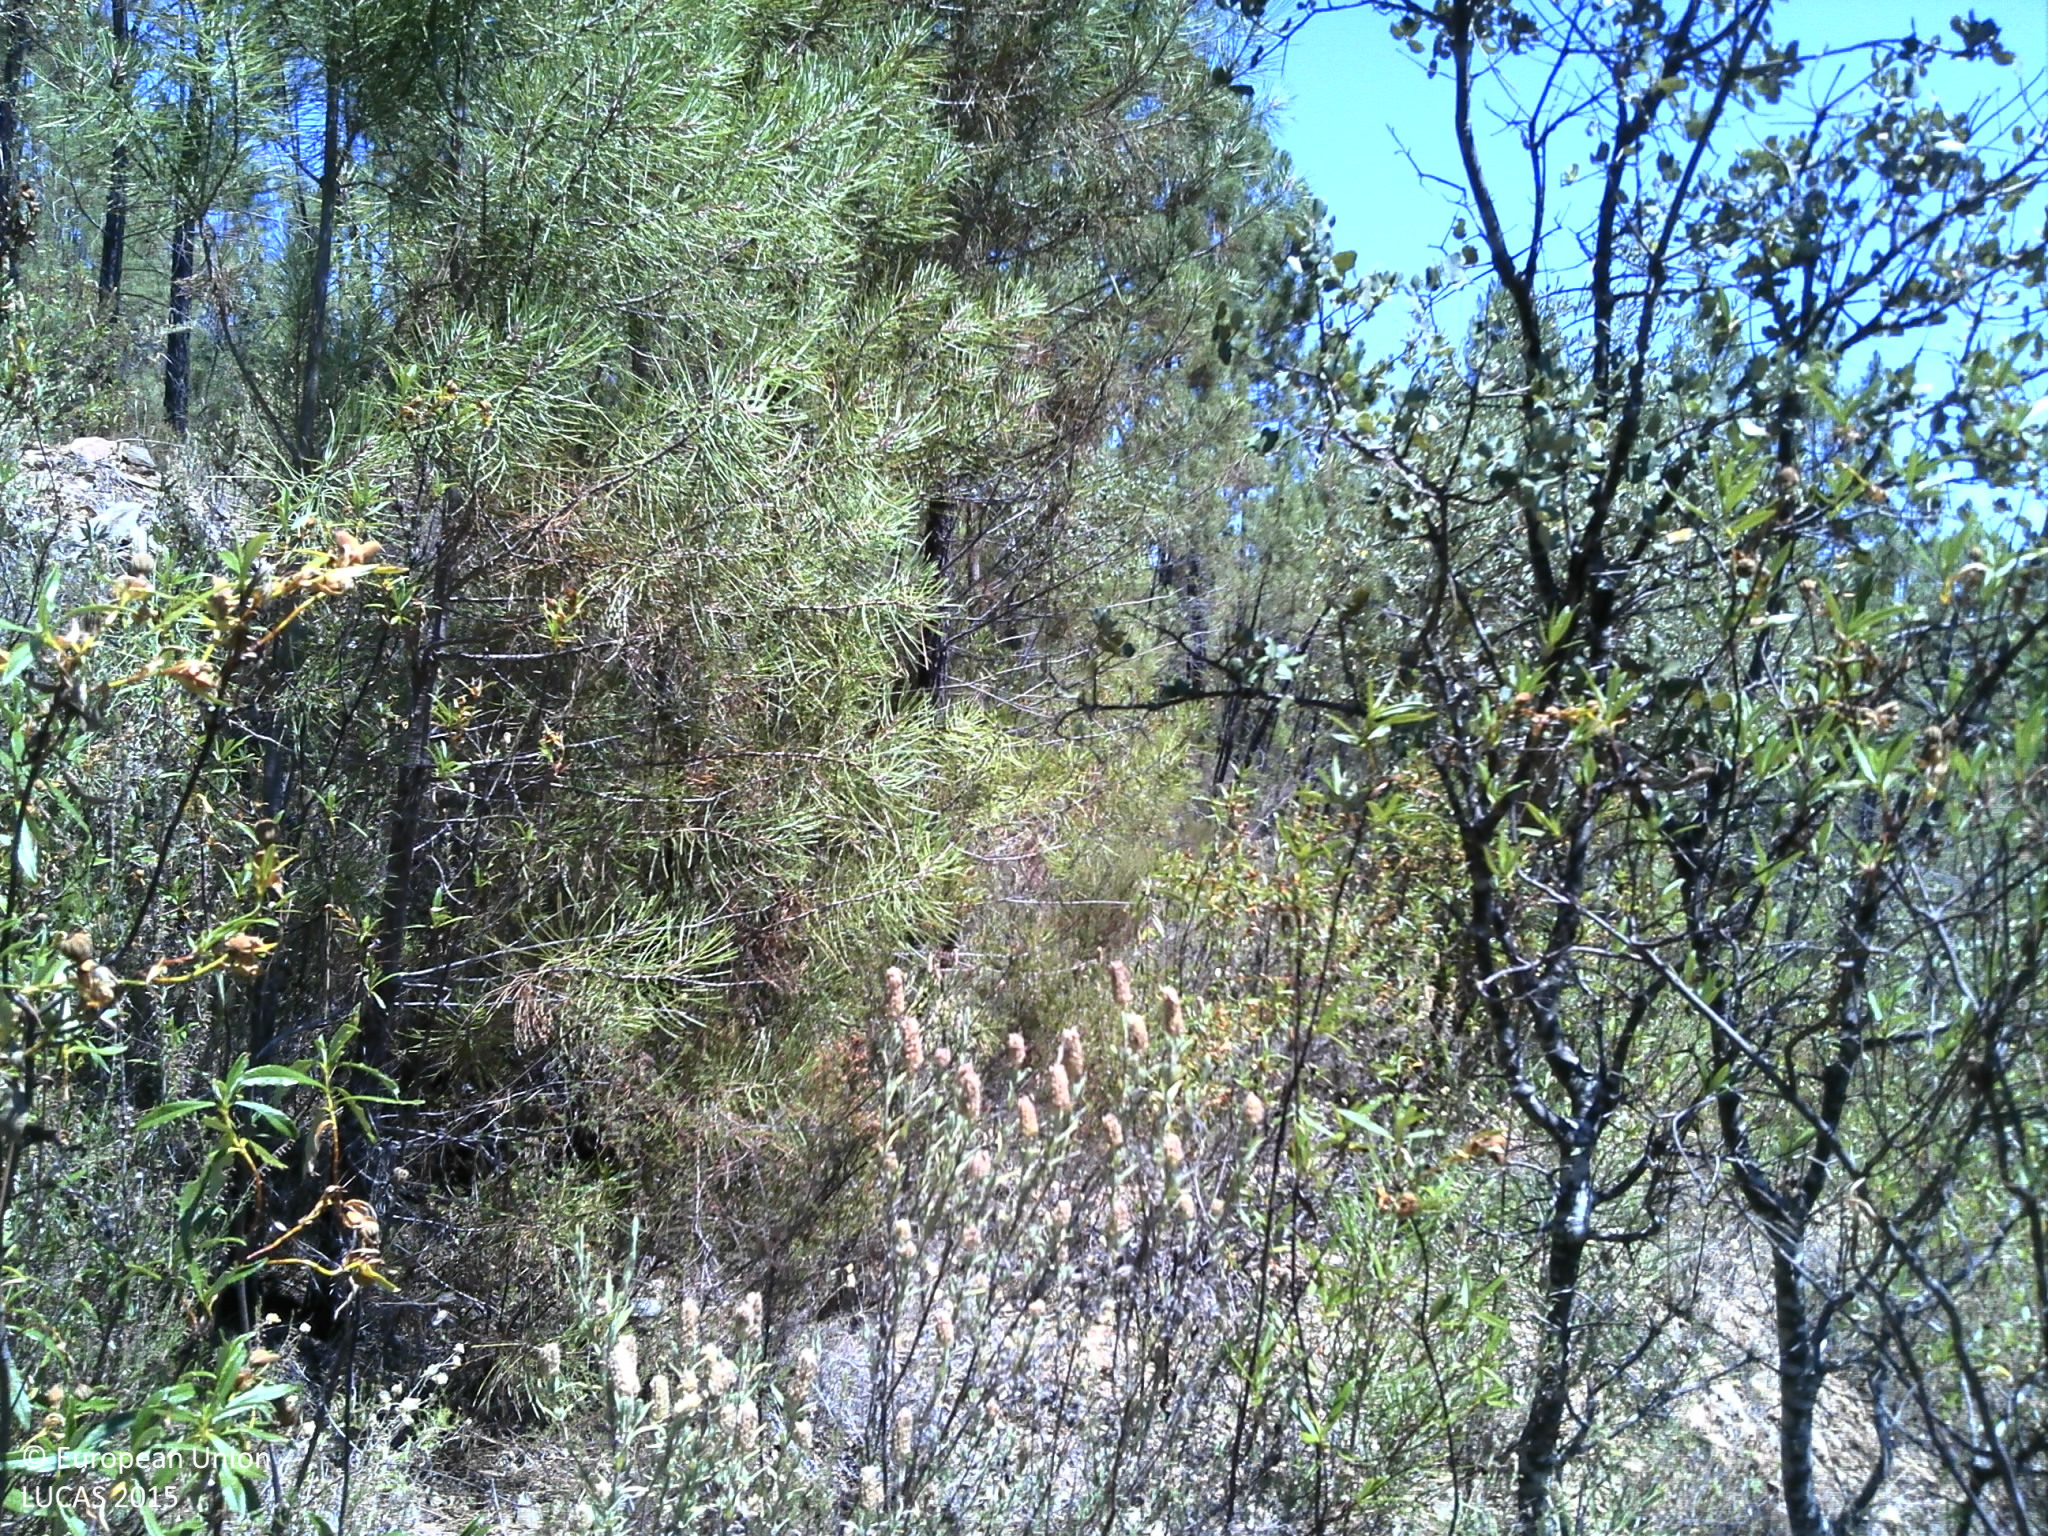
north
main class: Cropland
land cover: Olive groves
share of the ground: < 10 %
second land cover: Shrubland without tree cover
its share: > 75 %
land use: Abandoned areas
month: July
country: PT
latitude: 39.7146
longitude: -7.8003
